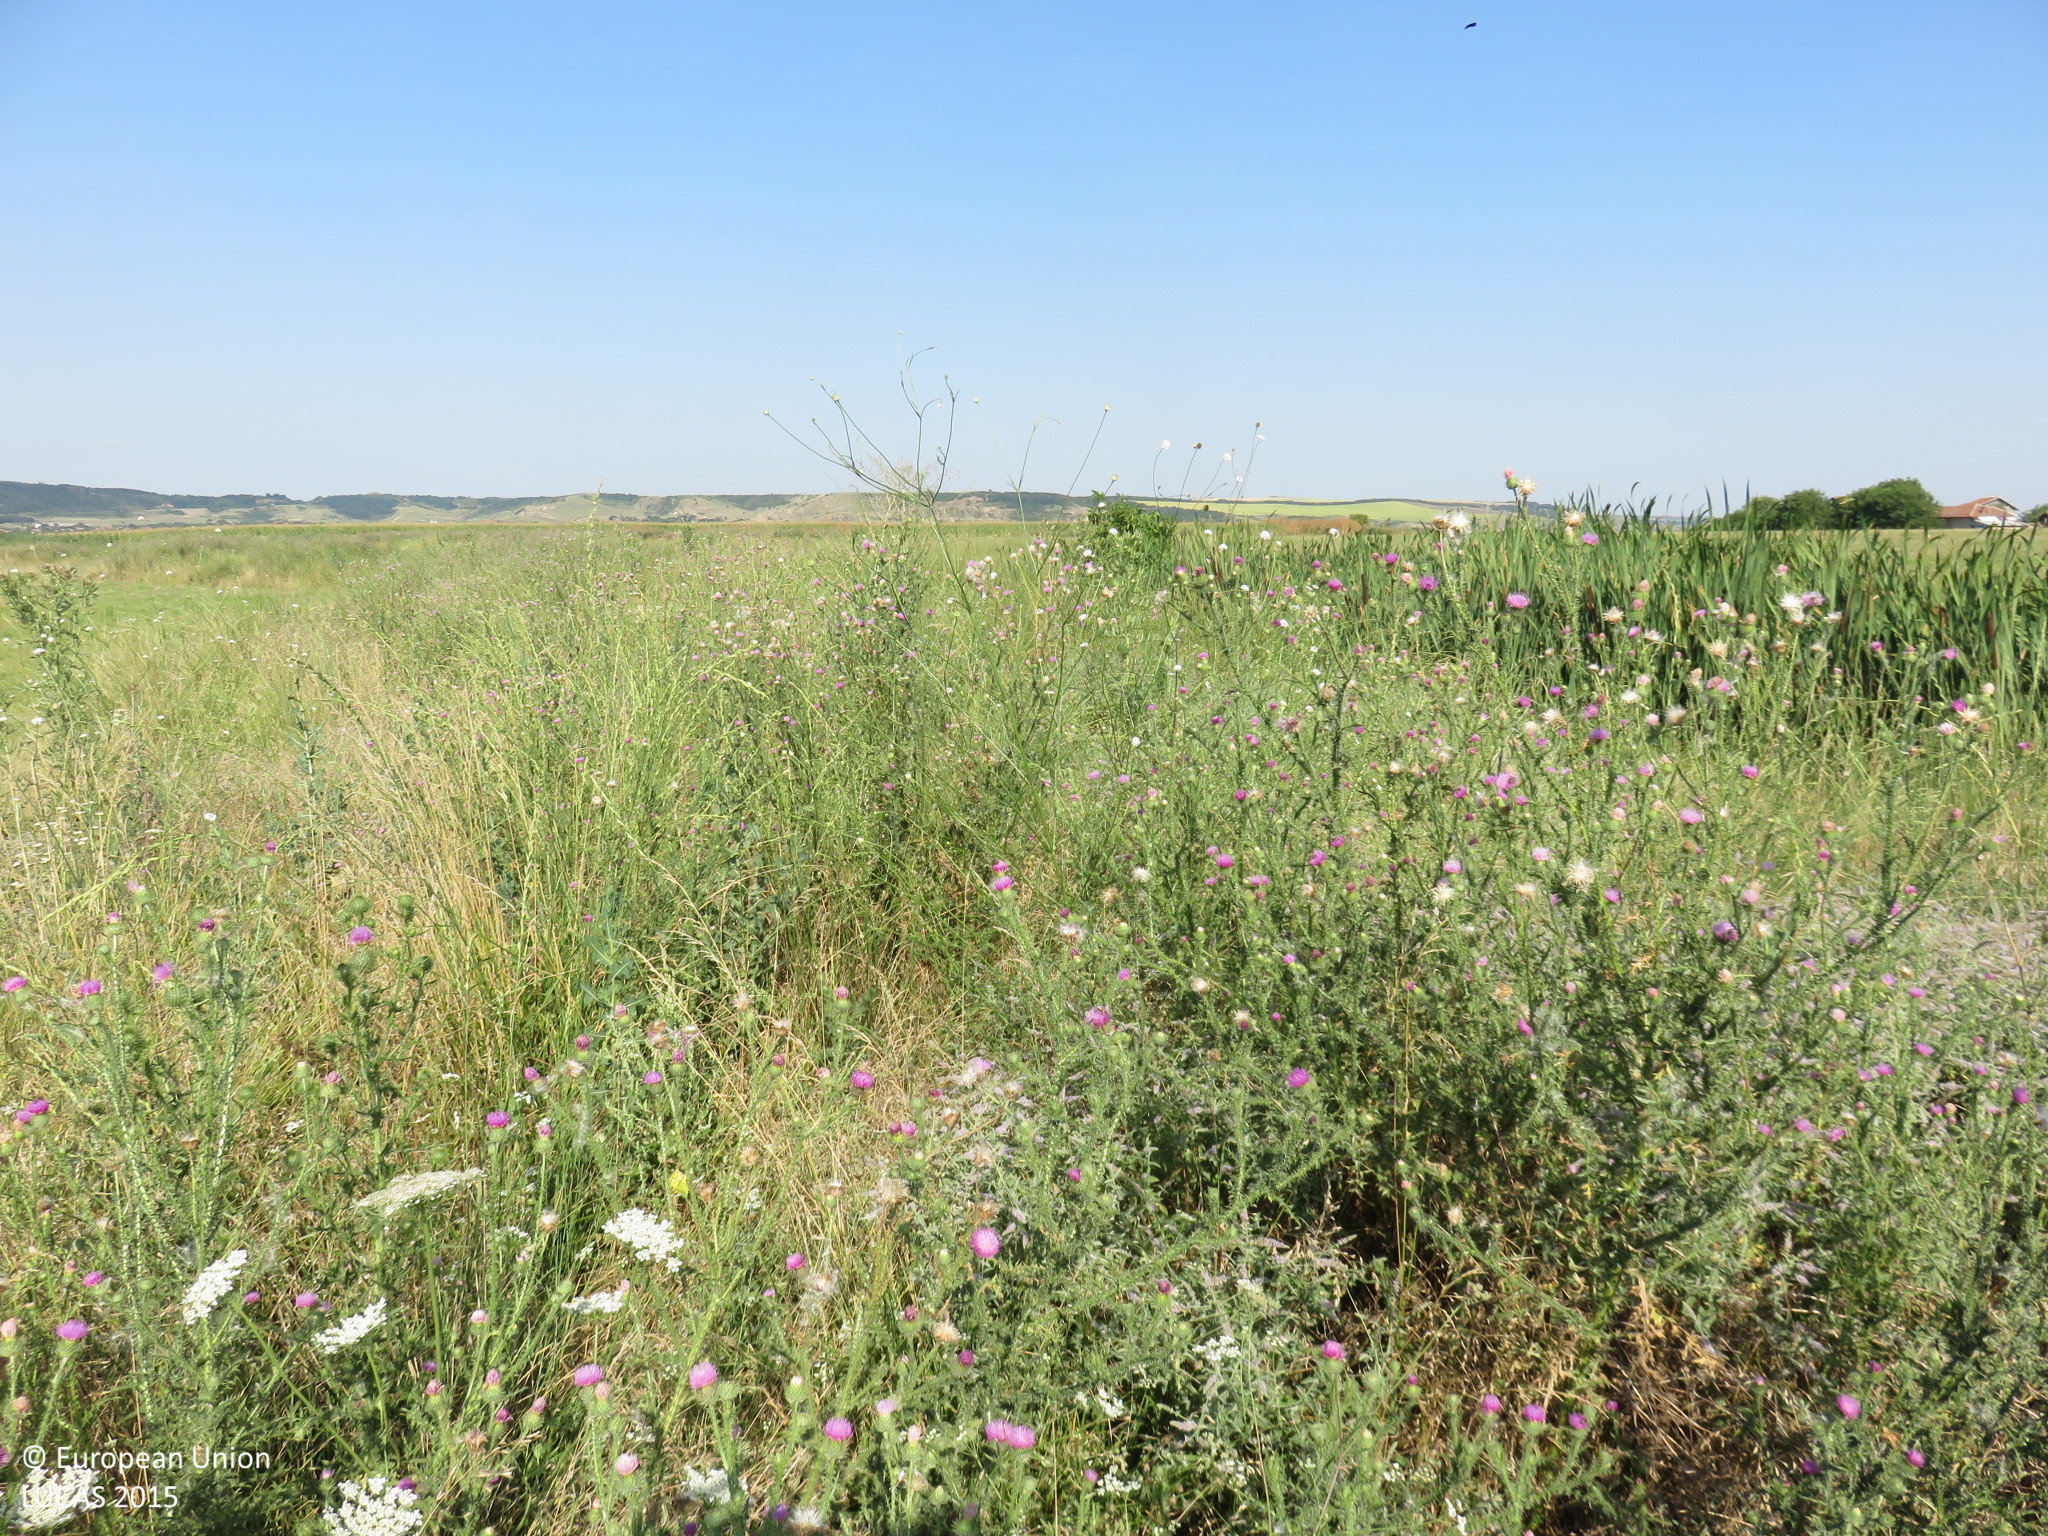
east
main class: Grassland
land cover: Grassland without tree/shrub cover
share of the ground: > 75 %
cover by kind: herbaceous plants 100 %
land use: Agriculture (excluding fallow land and kitchen gardens)
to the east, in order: Grassland without tree/shrub cover; Rivers and streams; Spontaneously vegetated surfaces; Maize
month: July
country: BG
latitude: 43.3994
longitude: 25.1236
